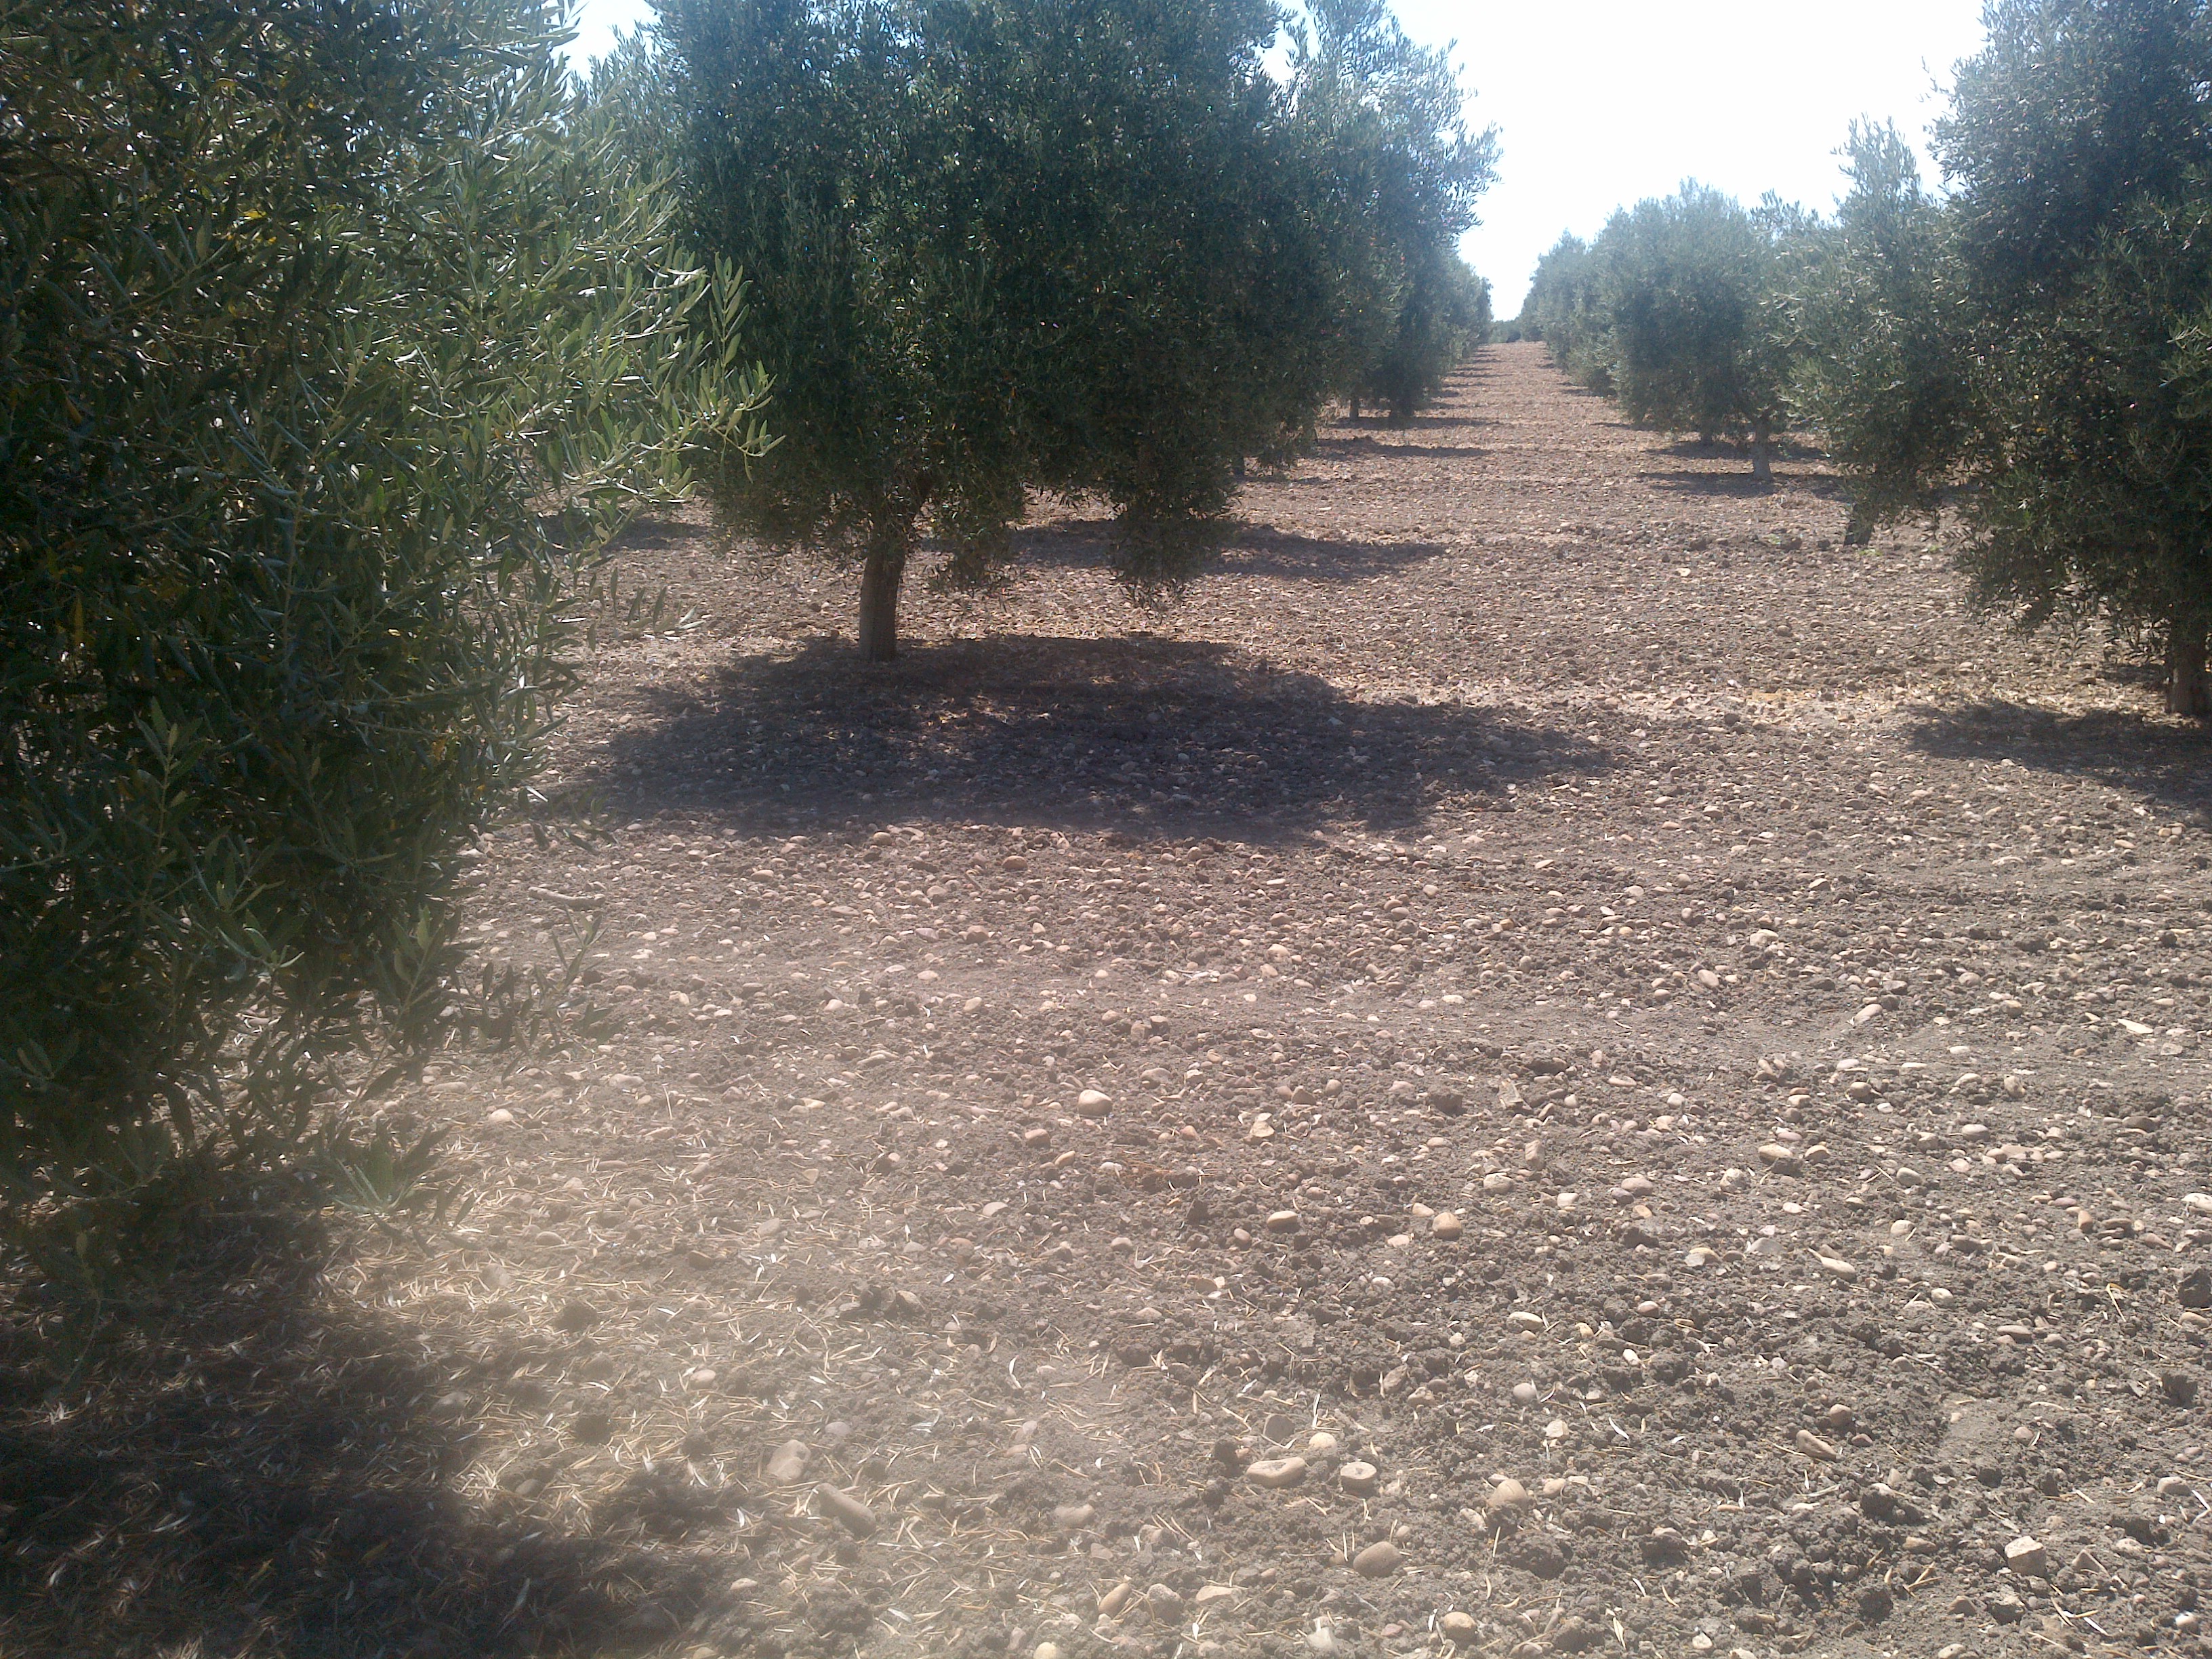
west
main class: Cropland
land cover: Olive groves
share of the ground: 50 - 75 %
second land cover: Other bare soil
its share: > 75 %
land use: Agriculture (excluding fallow land and kitchen gardens)
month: June
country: ES
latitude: 37.5997
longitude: -4.8828
